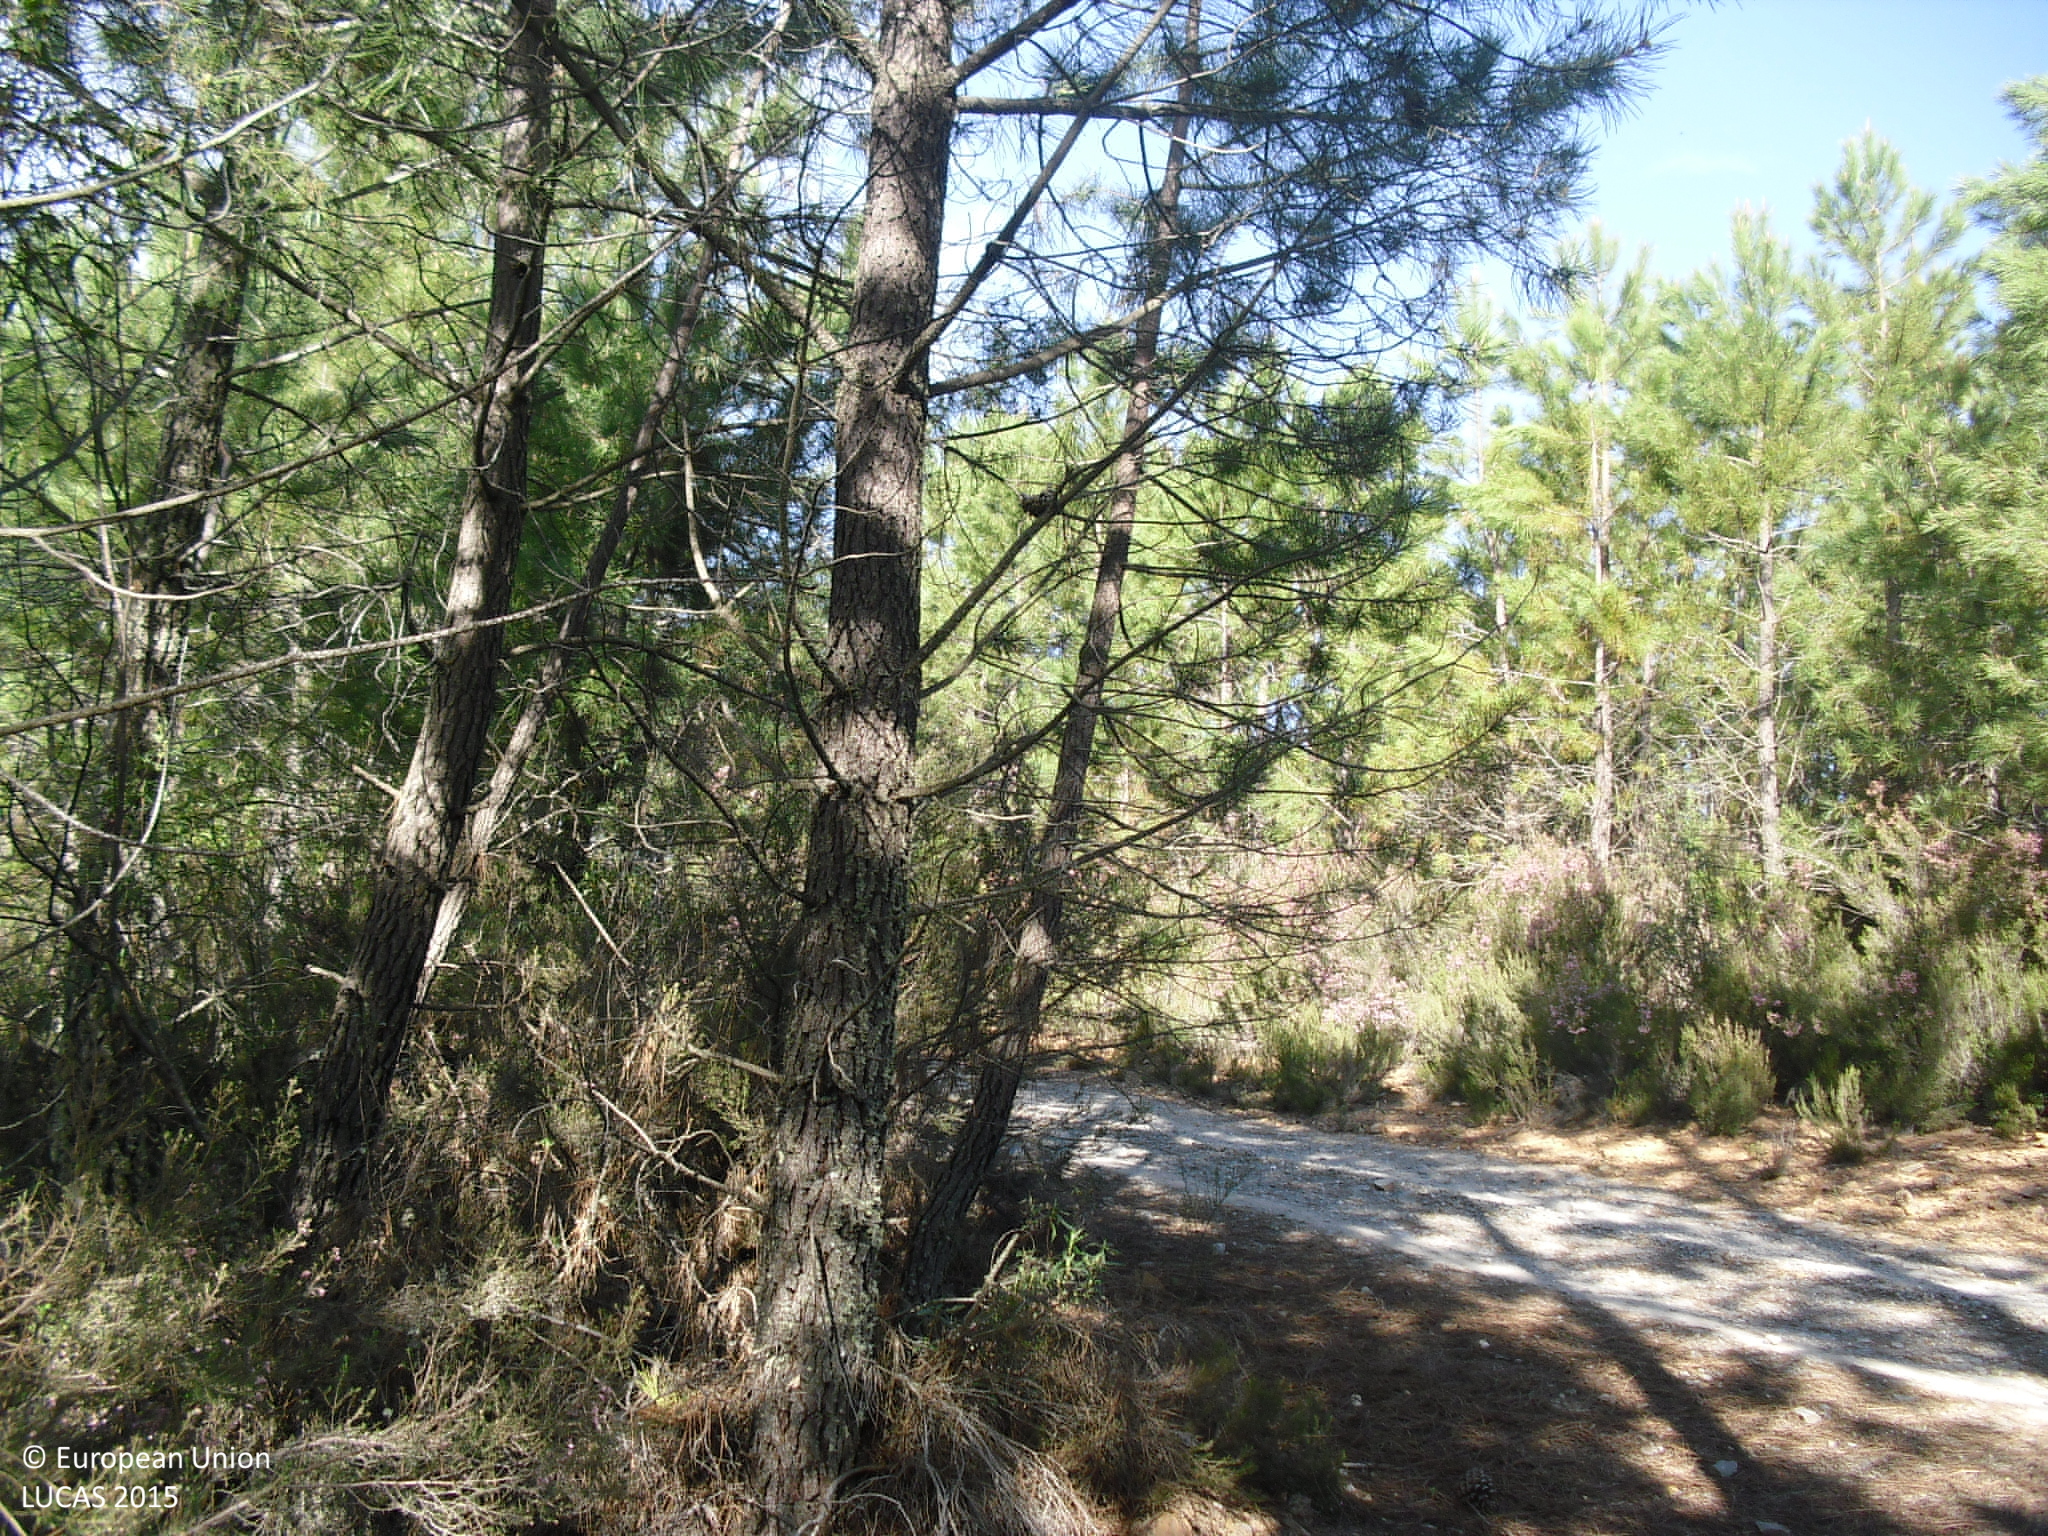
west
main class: Woodland
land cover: Pine dominated coniferous woodland
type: coniferous forest of the mediterranean region
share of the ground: > 75 %
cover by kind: coniferous forest trees 100 %
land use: Forestry
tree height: > 5 m
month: April
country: ES
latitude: 39.4941
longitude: -5.3398
